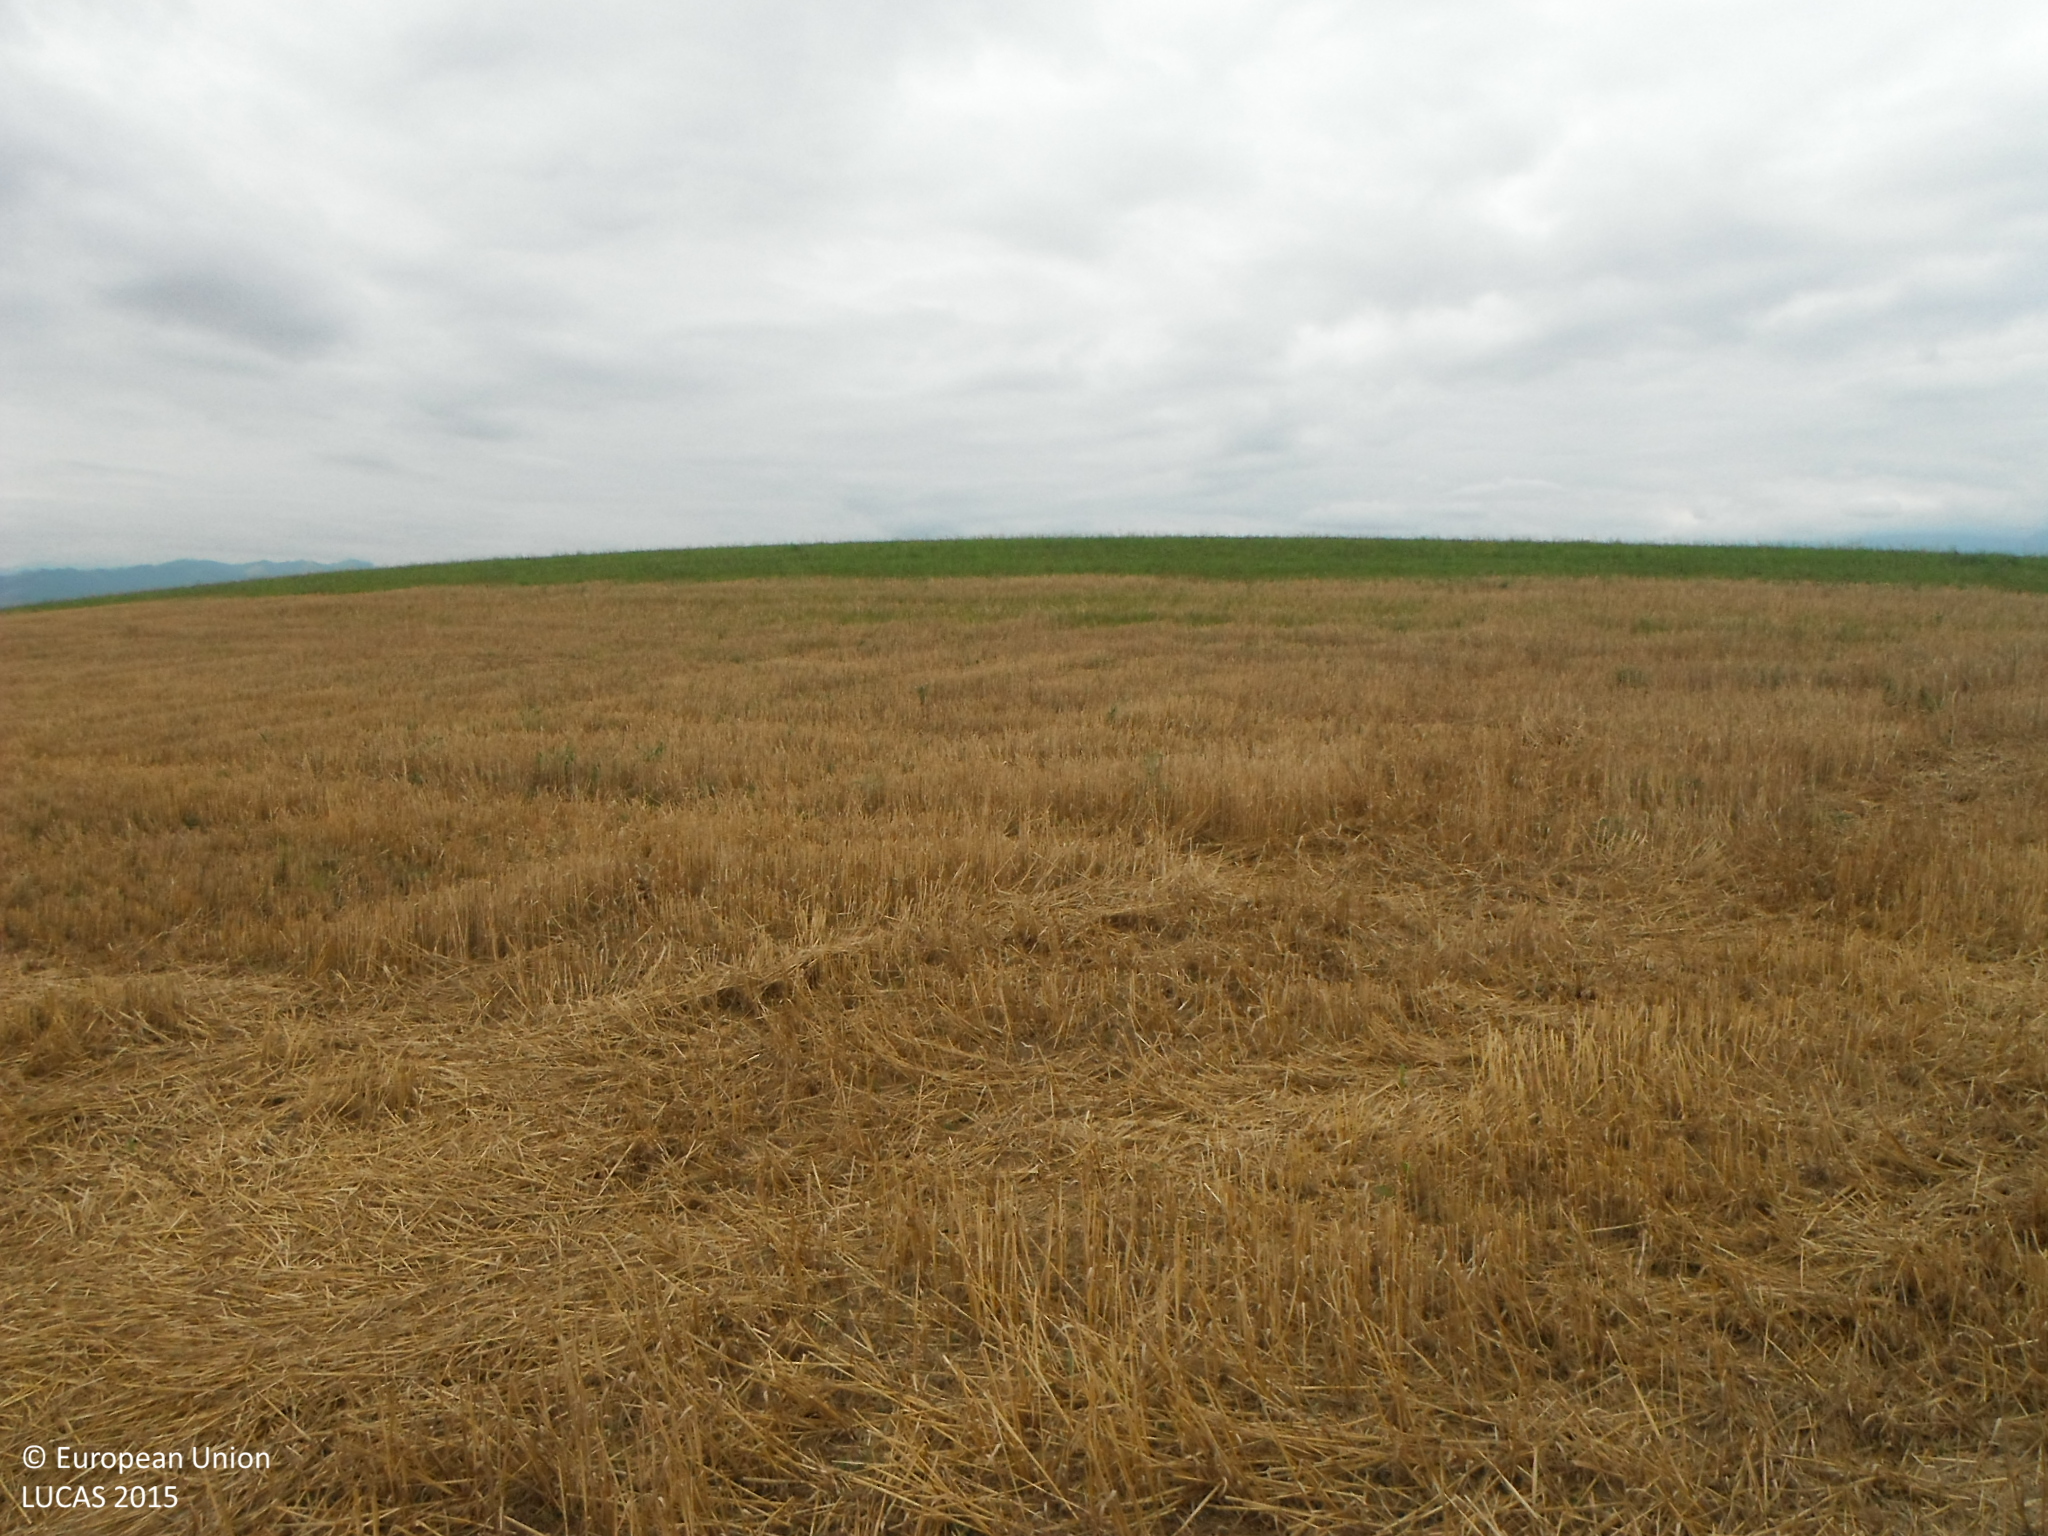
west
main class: Cropland
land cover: Barley
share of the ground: > 75 %
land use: Agriculture (excluding fallow land and kitchen gardens)
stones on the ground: 25 - 50 %
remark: Harvested field
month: August
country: SK
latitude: 49.0753
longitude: 20.3704
